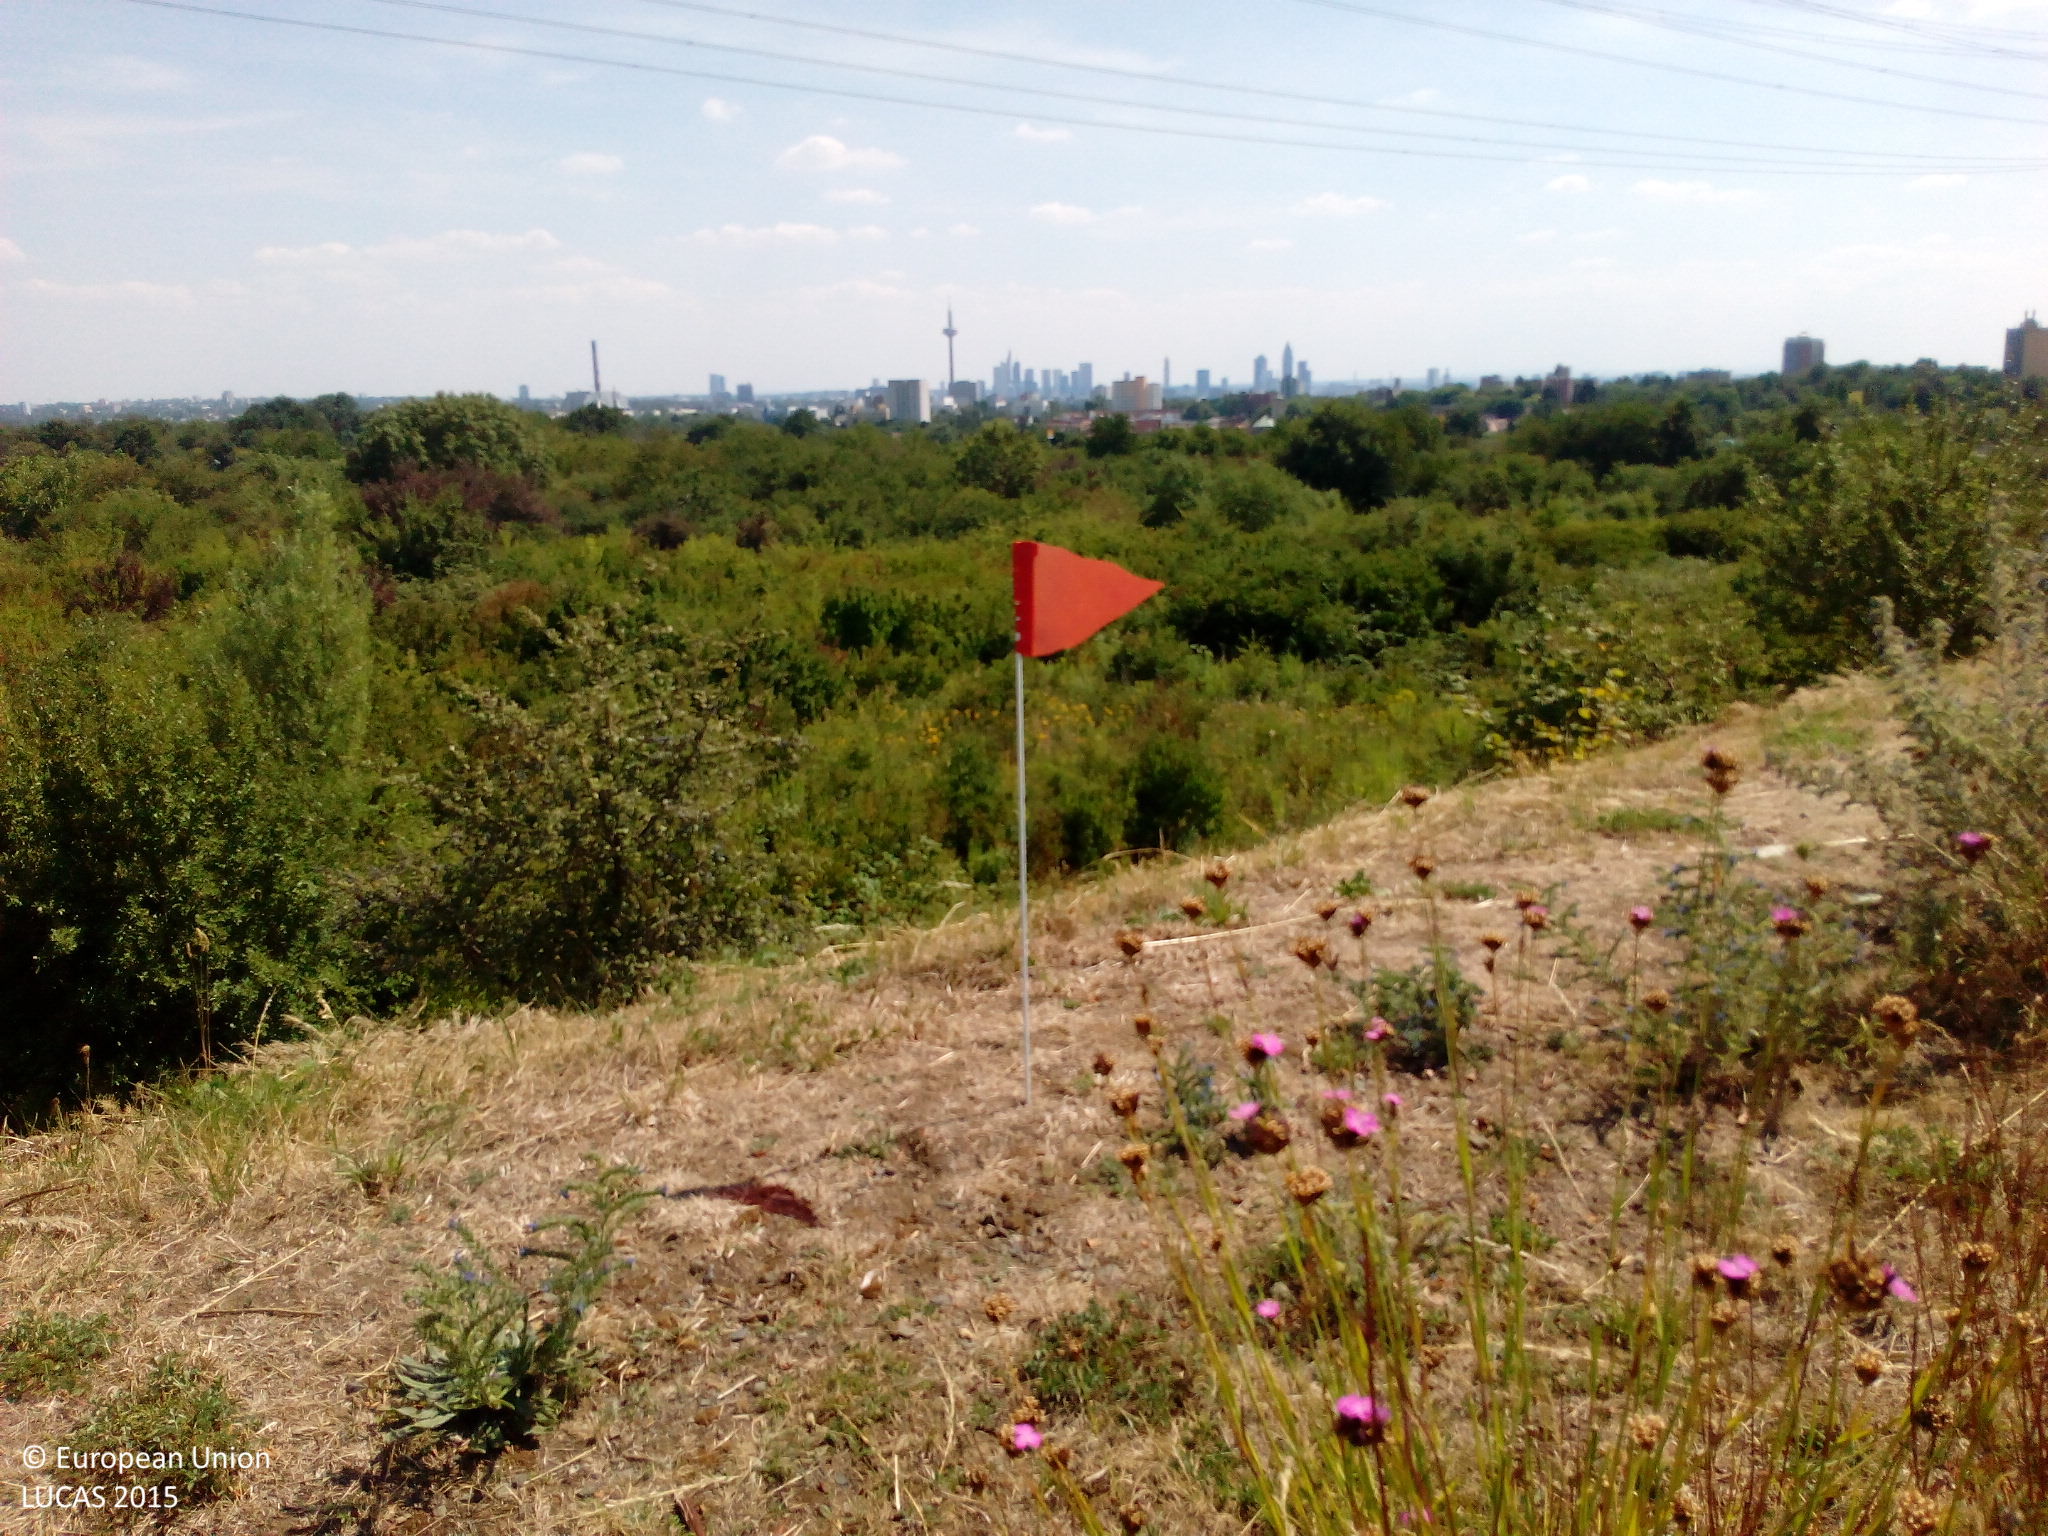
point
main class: Shrubland
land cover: Shrubland without tree cover
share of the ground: > 75 %
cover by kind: herbaceous plants 80 %, shrubs 15 %, unconsolidated bare surface 5 %
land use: Road transport
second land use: Protection infrastructures
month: August
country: DE
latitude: 50.1758
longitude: 8.6141
